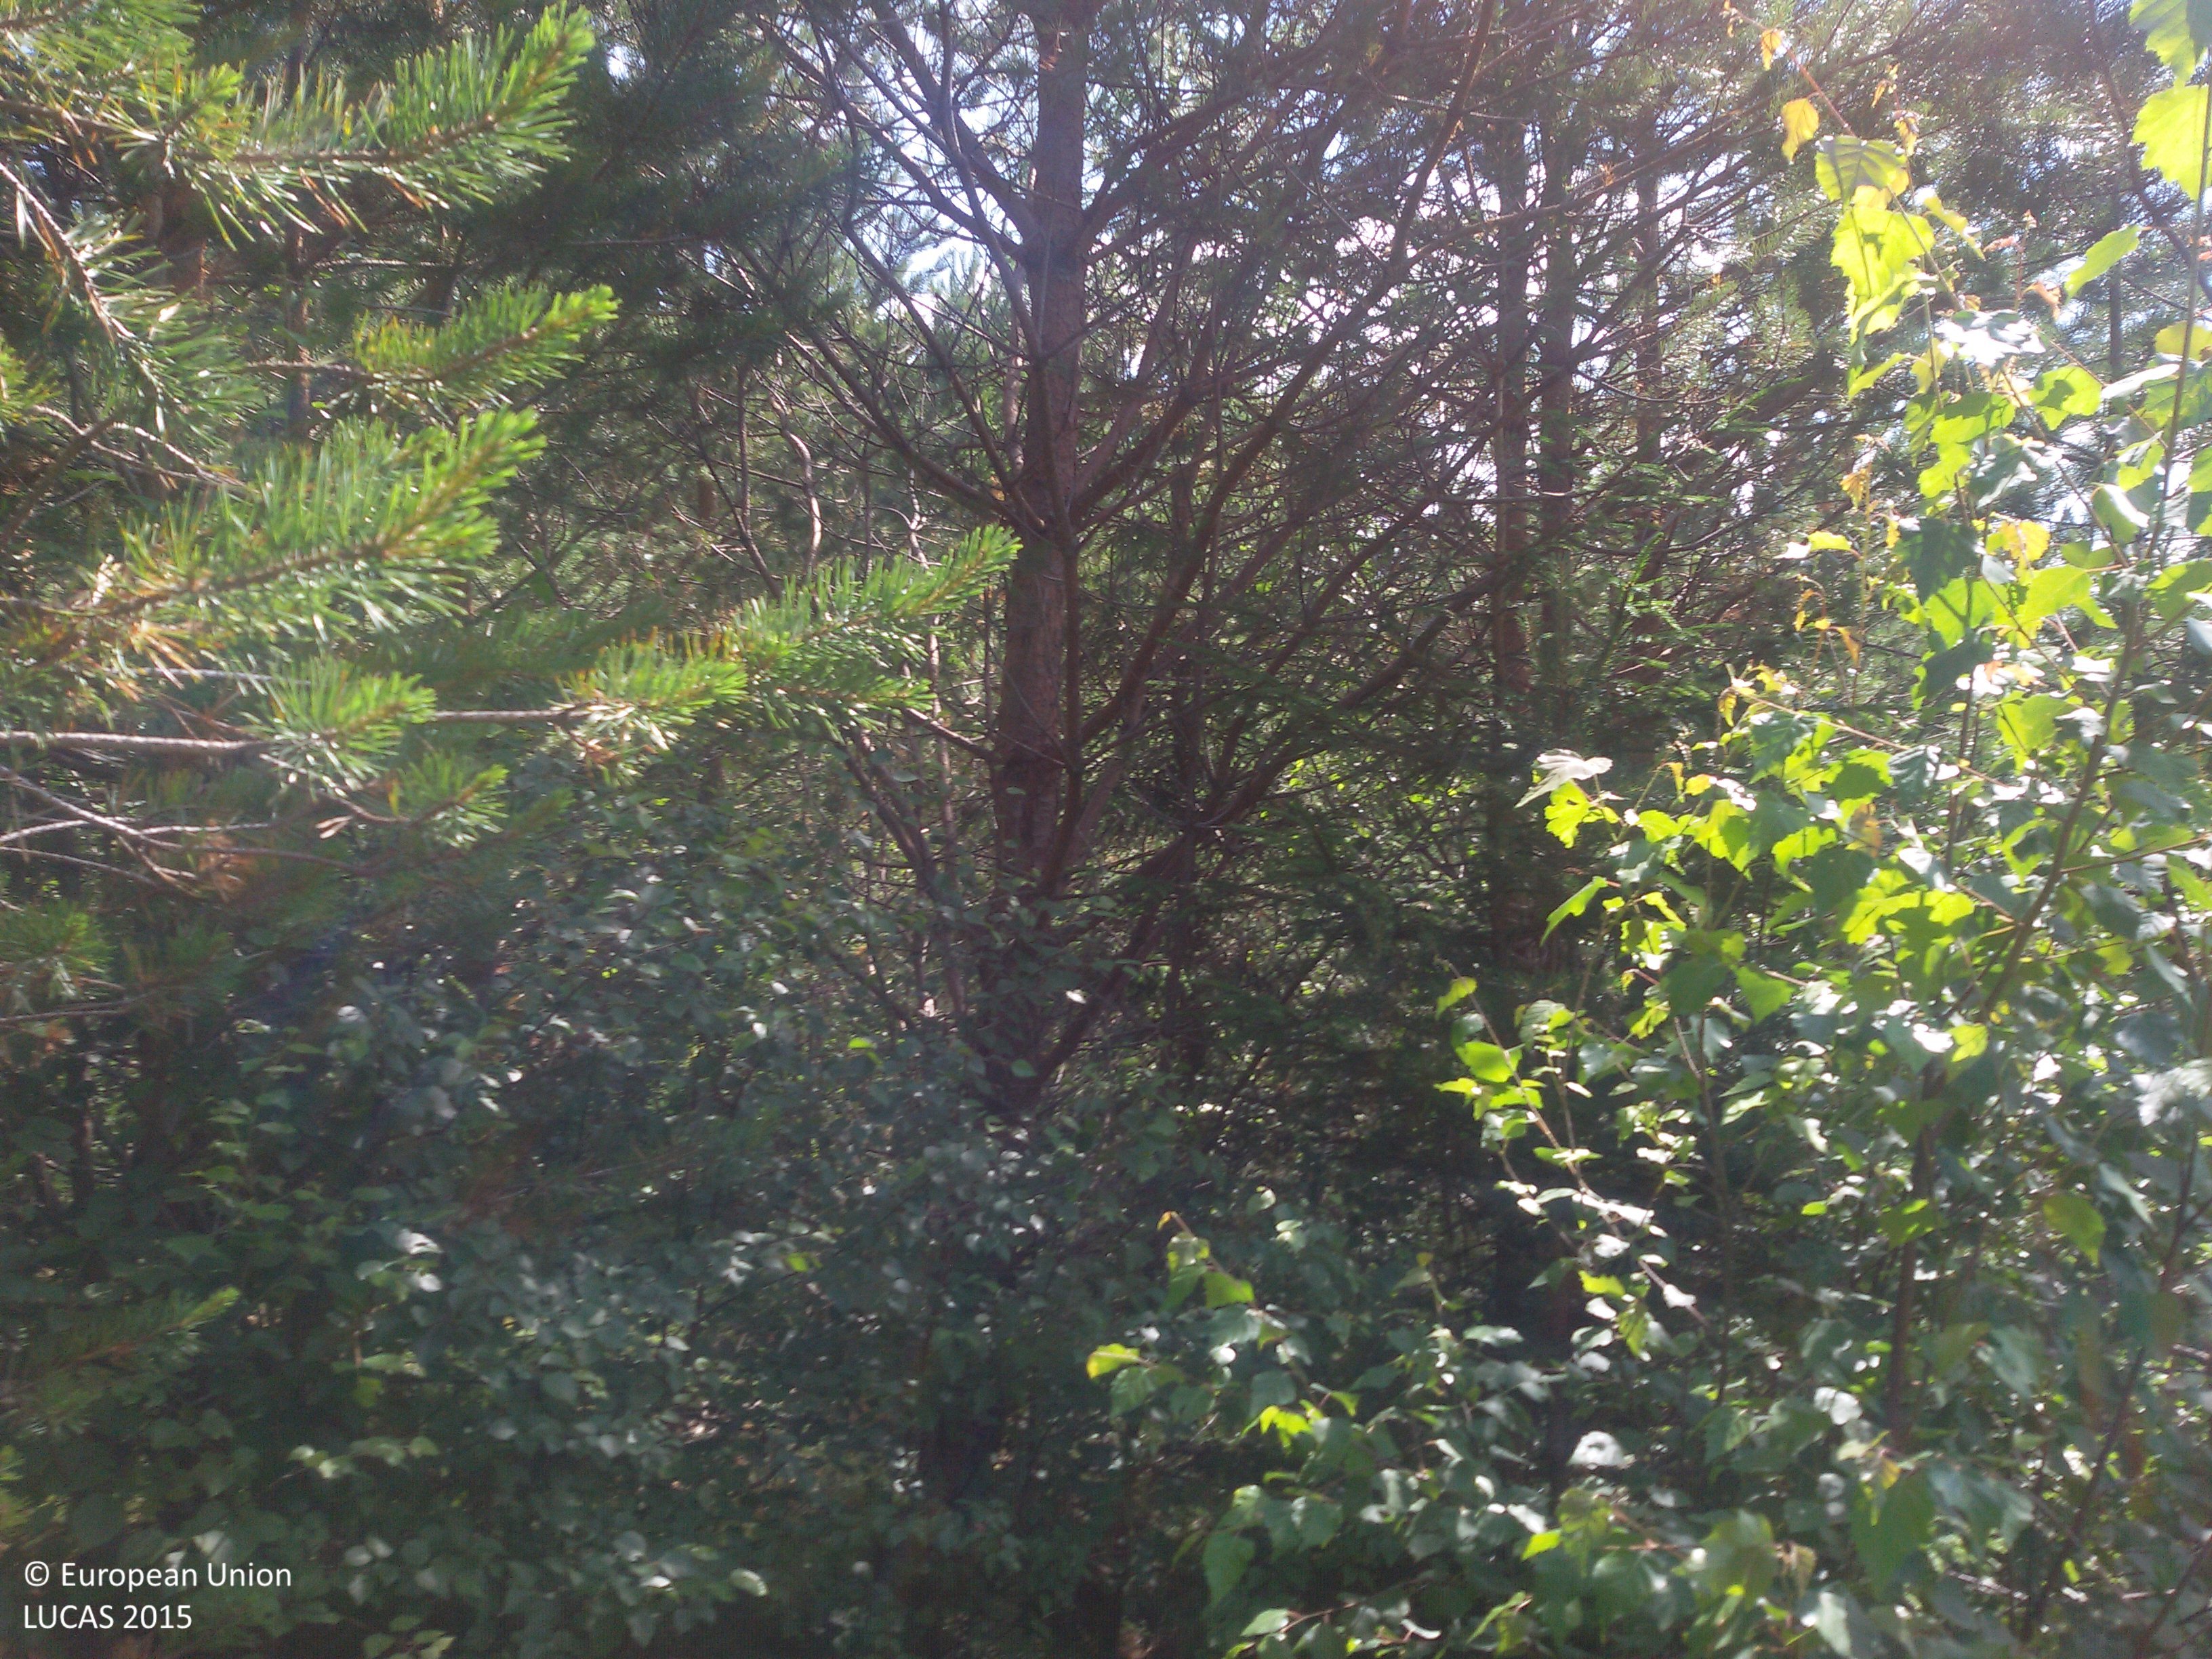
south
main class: Woodland
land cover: Pine dominated mixed woodland
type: boreal forest
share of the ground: > 75 %
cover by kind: coniferous forest trees 70 %, broadleaved forest trees 30 %
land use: Forestry
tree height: < 5 m
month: July
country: SE
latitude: 60.4726
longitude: 14.9538
